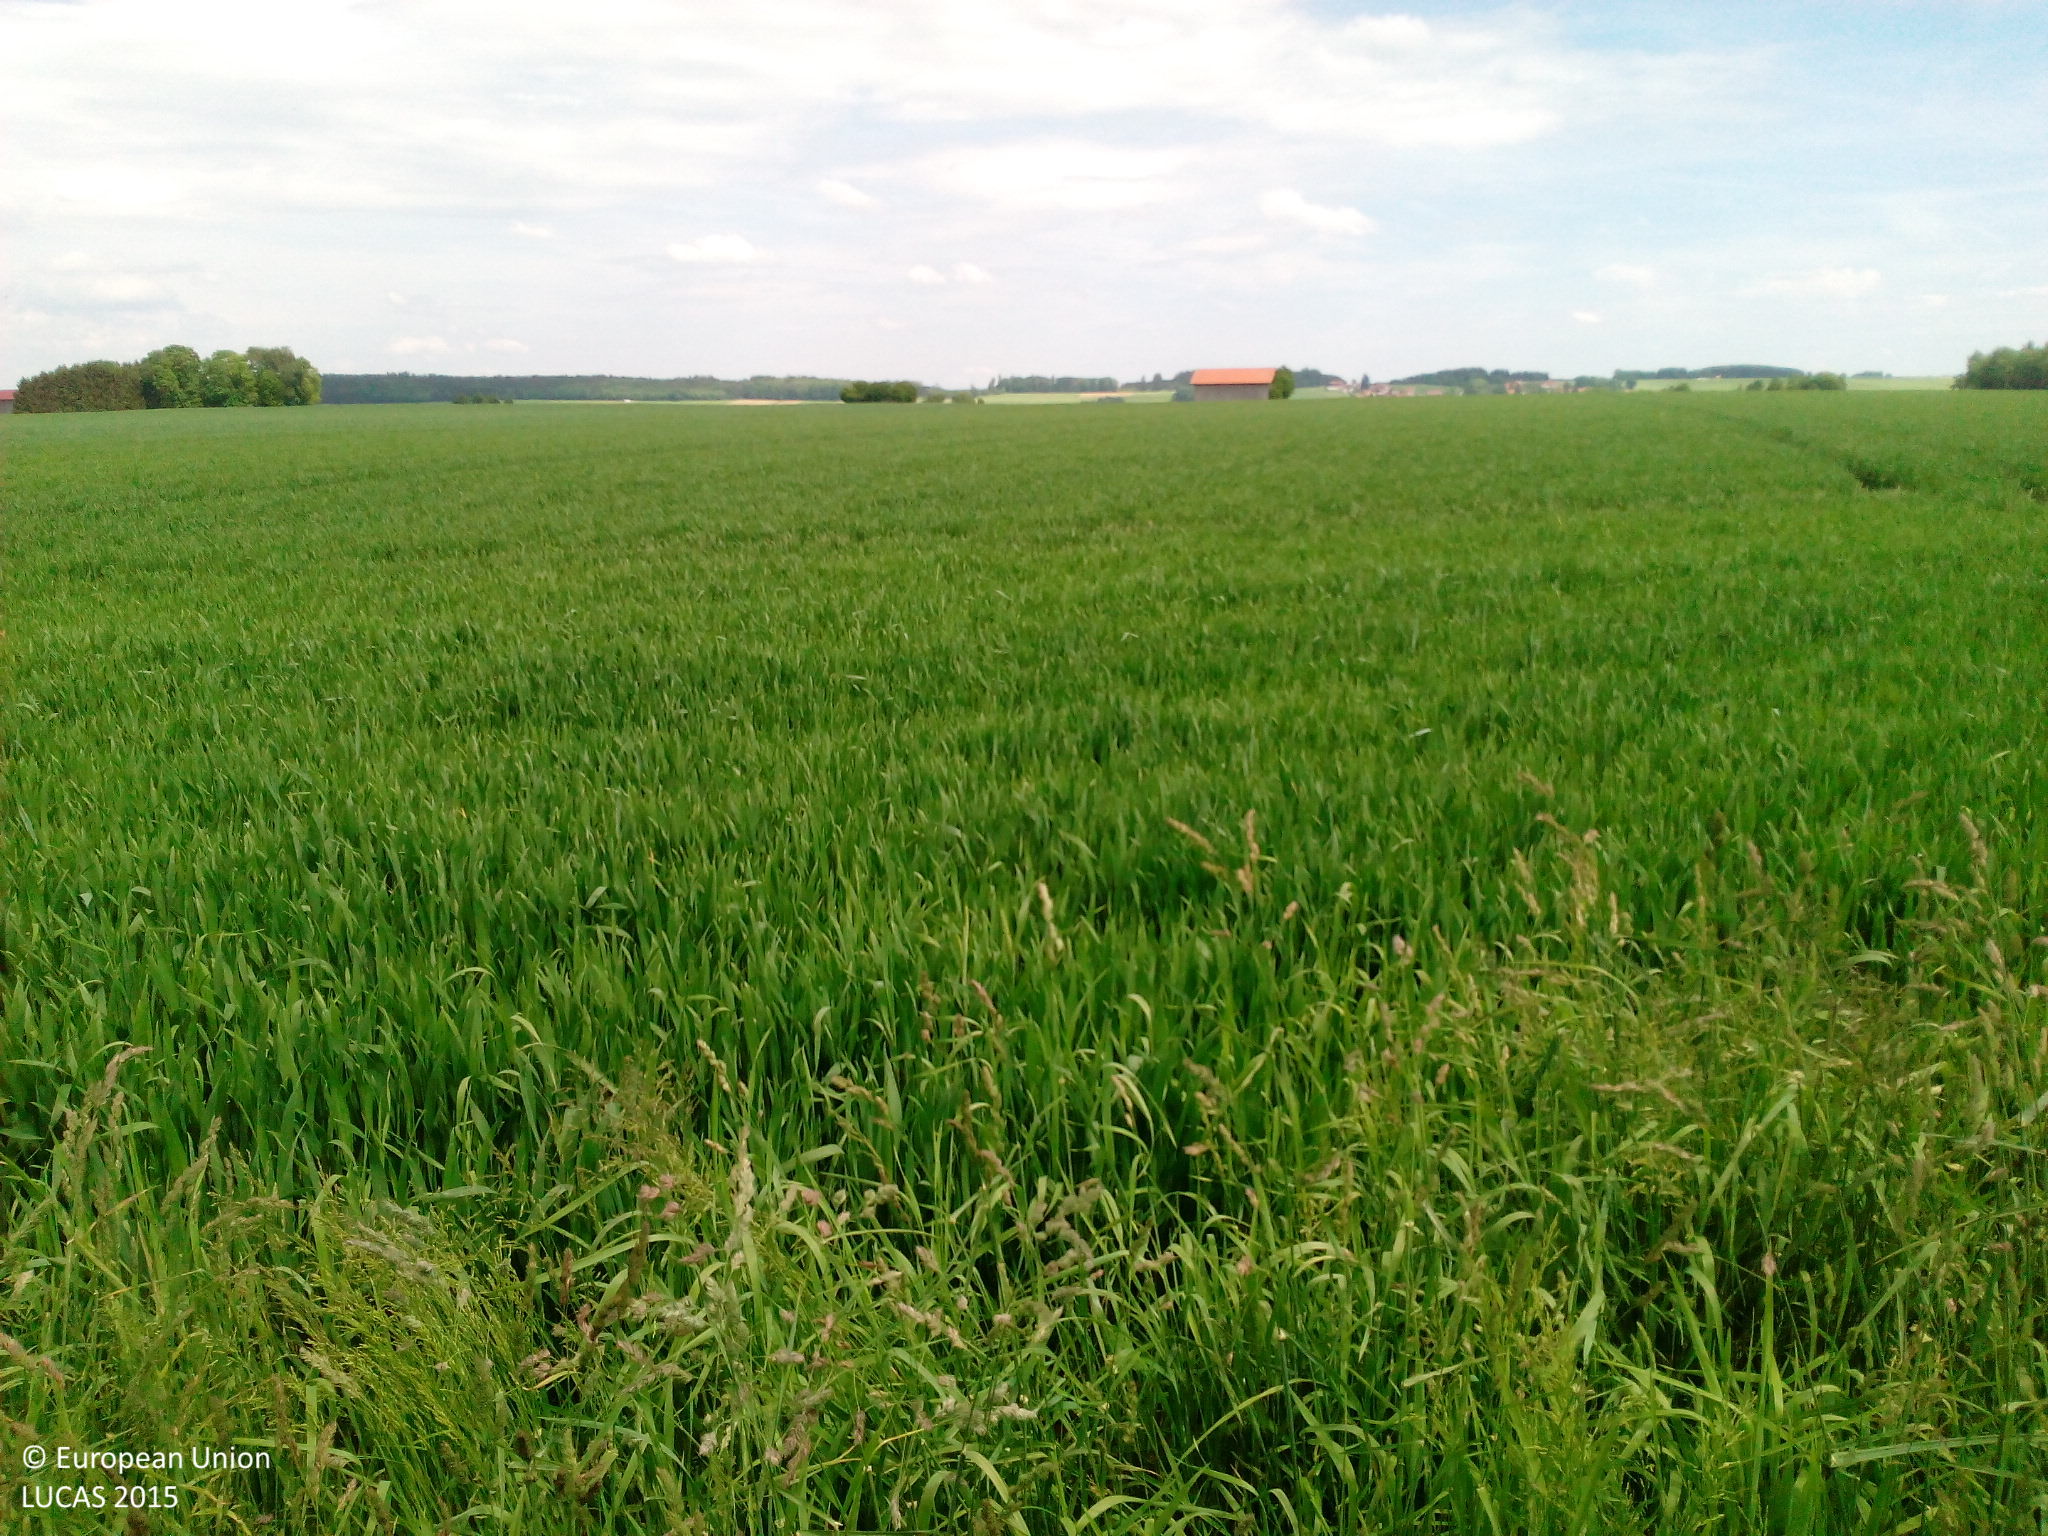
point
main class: Cropland
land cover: Rye
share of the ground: > 75 %
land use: Agriculture (excluding fallow land and kitchen gardens)
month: May
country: DE
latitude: 48.1692
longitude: 10.2553
